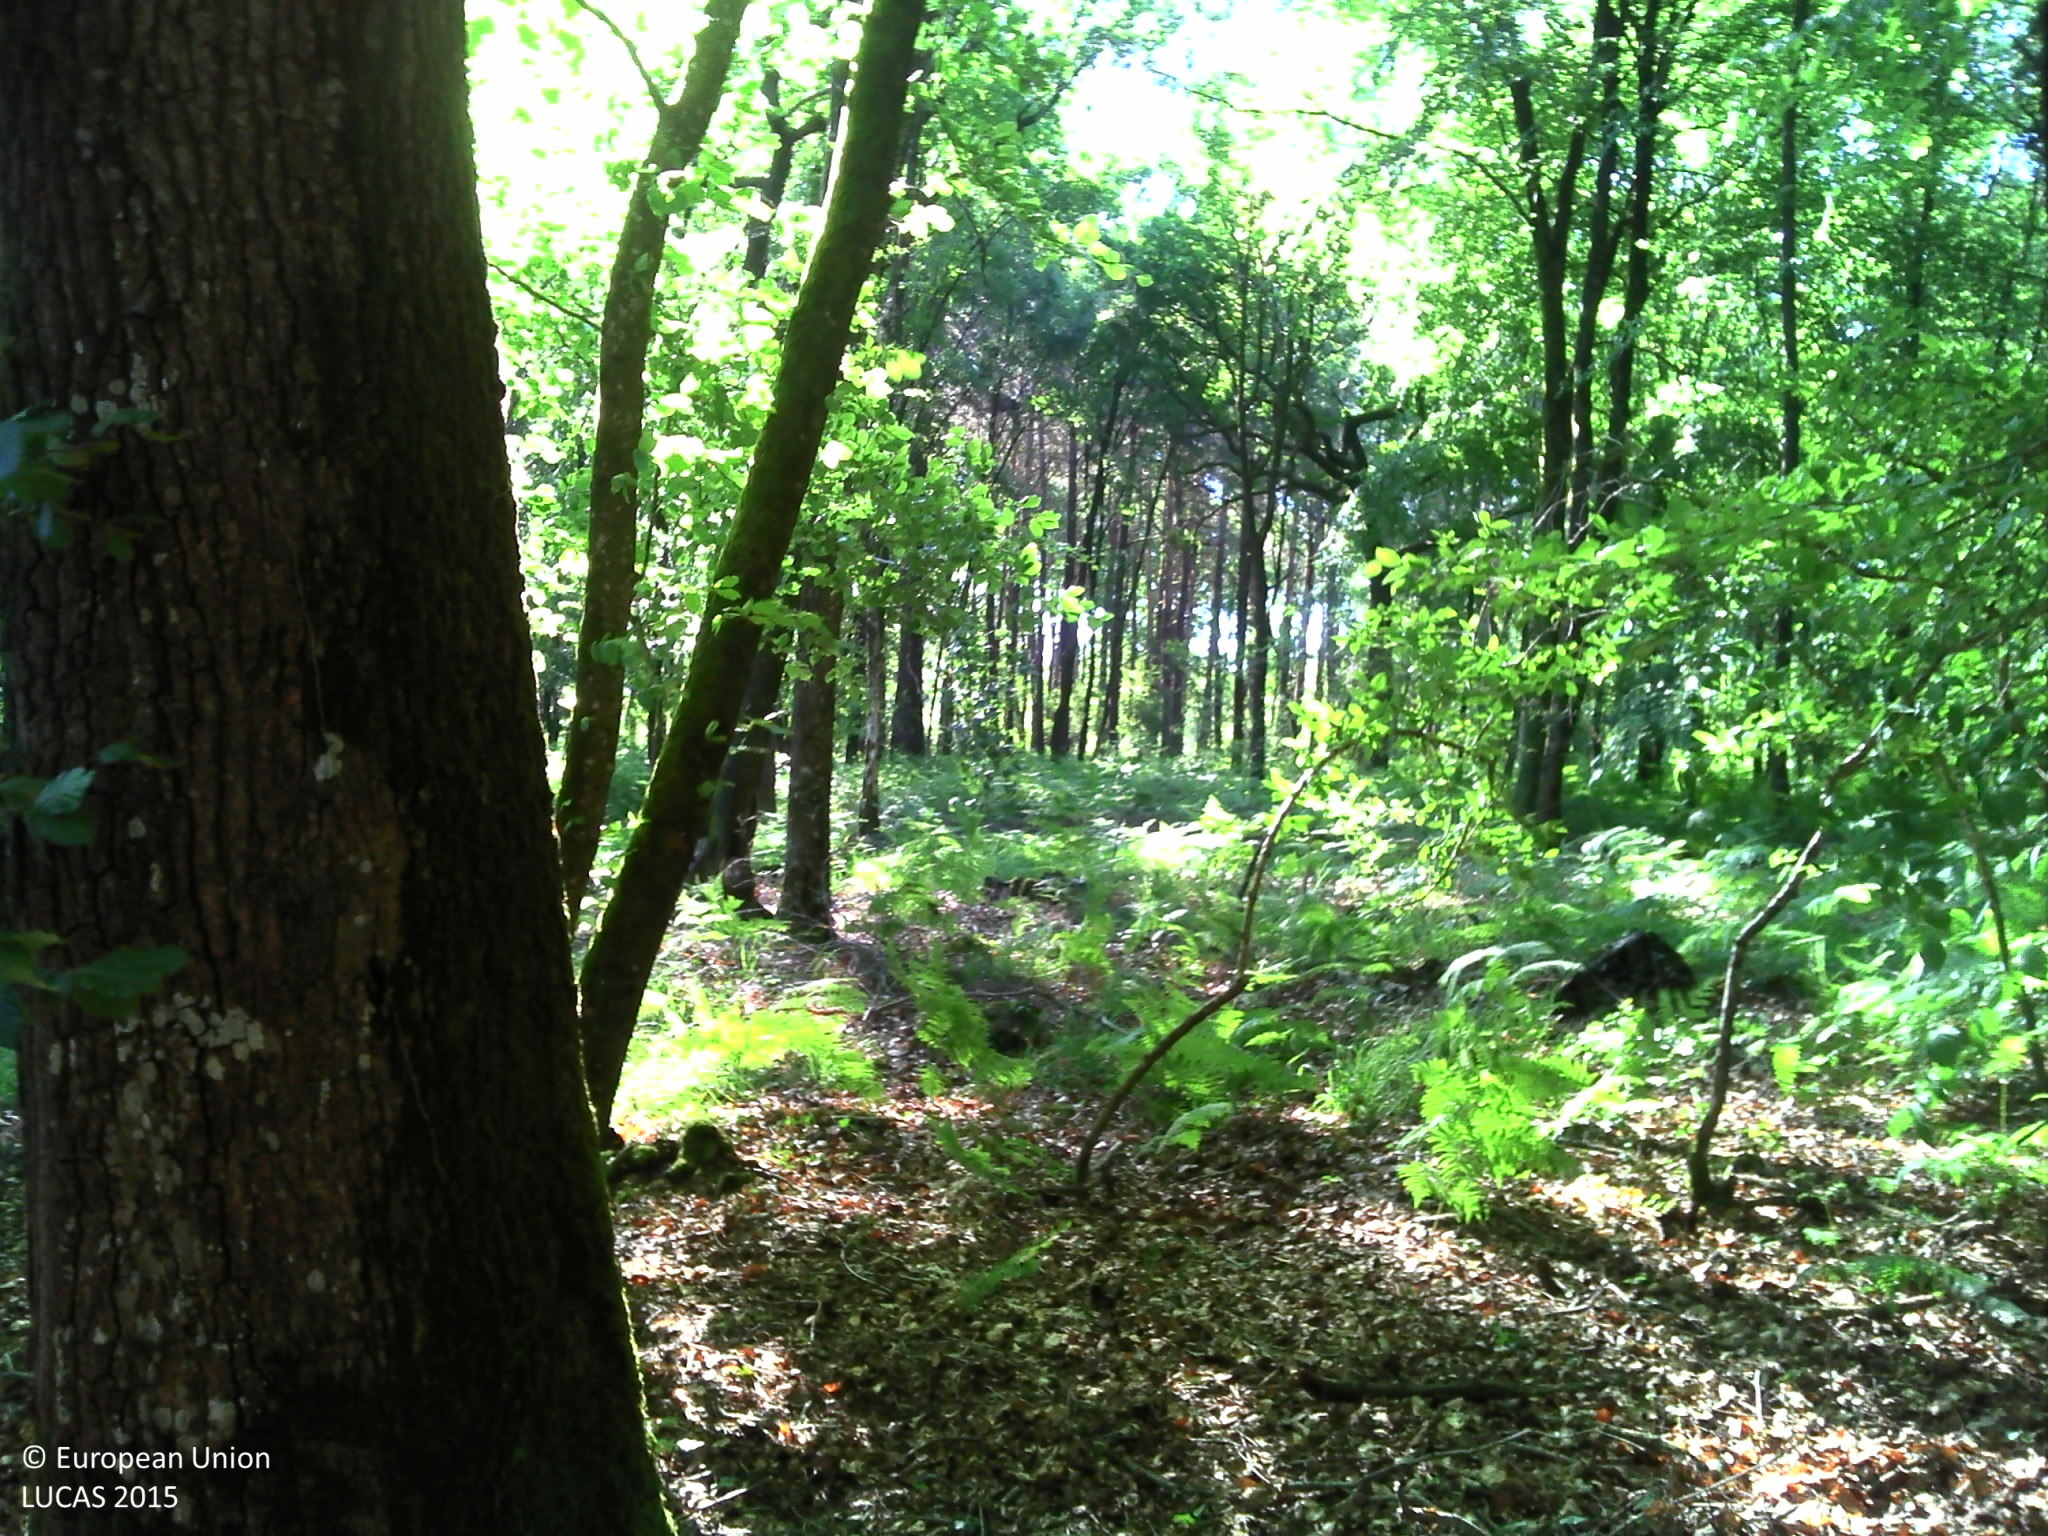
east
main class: Woodland
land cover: Broadleaved woodland
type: acidophilous oak and oak-birch forest
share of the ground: > 75 %
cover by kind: broadleaved forest trees 90 %, herbaceous plants 10 %
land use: Forestry
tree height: > 5 m
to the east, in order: Broadleaved woodland; Abandoned hedges; Ditches and canals; Fences; Grassland without tree/shrub cover
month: June
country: FR
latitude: 48.2113
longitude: -1.2256
